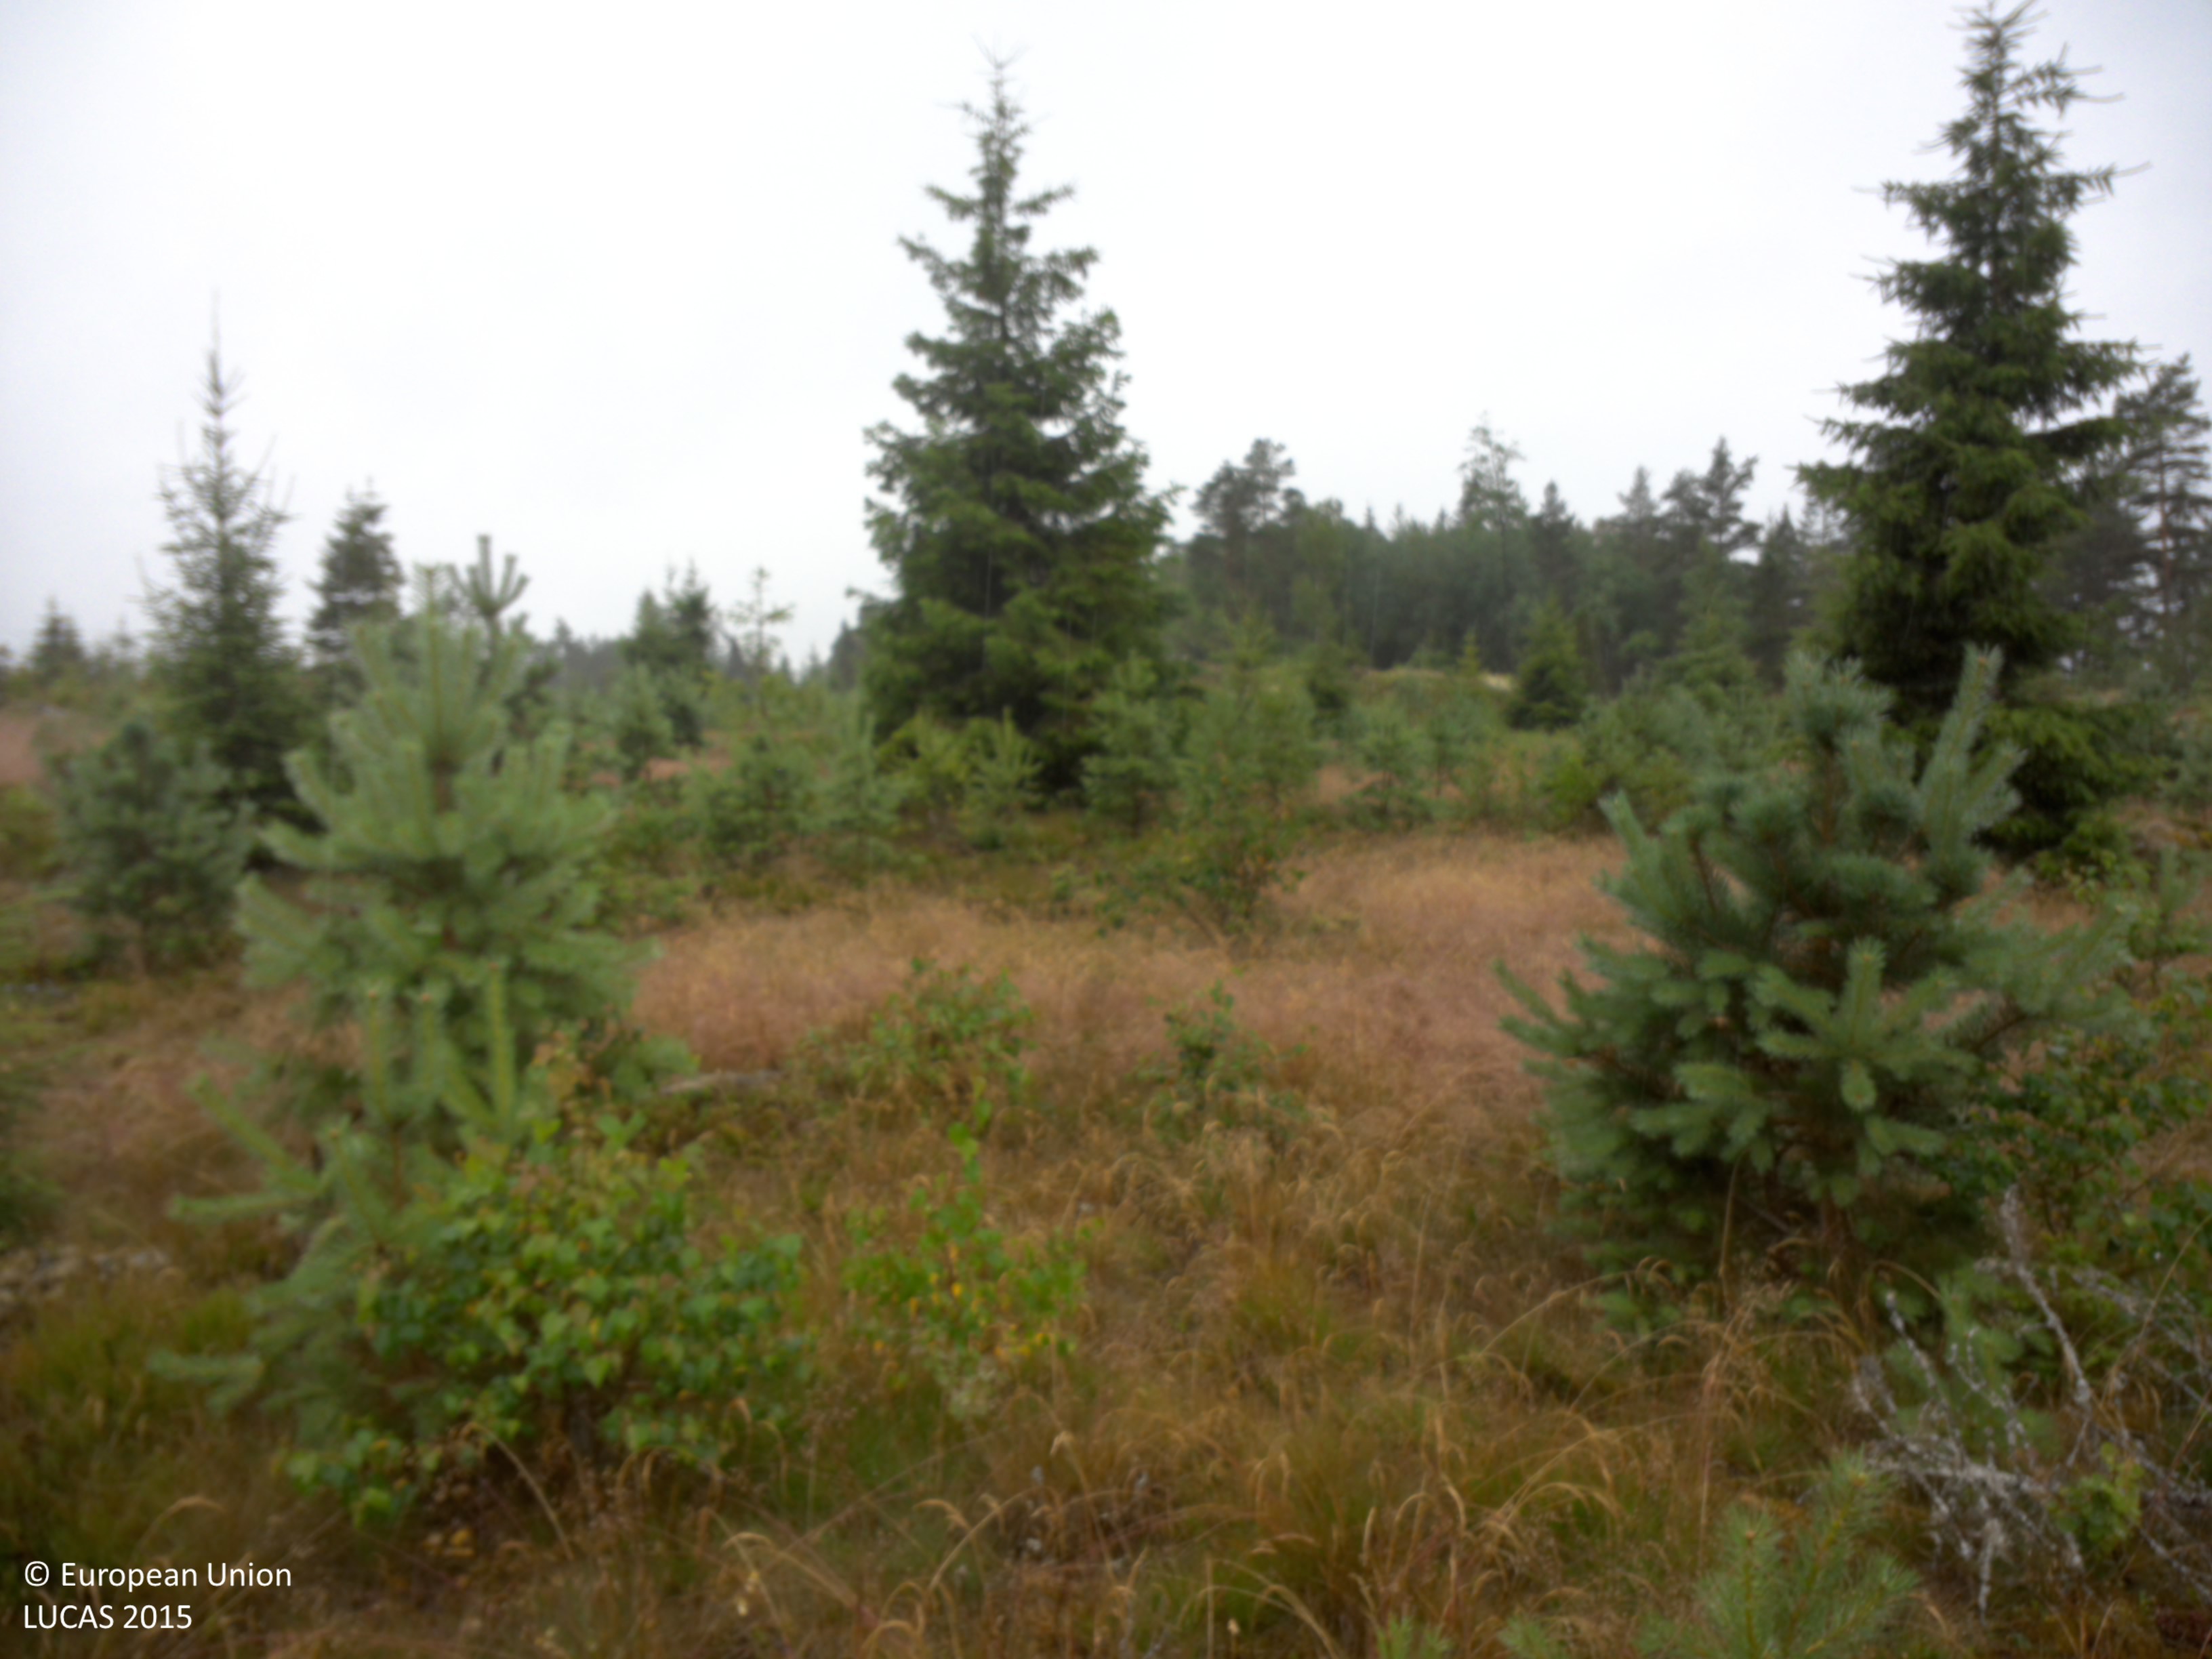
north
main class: Woodland
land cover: Pine dominated mixed woodland
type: boreal forest
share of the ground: 25 - 50 %
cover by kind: herbaceous plants 50 %, coniferous forest trees 30 %, broadleaved forest trees 20 %
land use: Forestry
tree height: < 5 m
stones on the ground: < 10 %
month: July
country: SE
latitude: 58.6773
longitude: 11.6348
